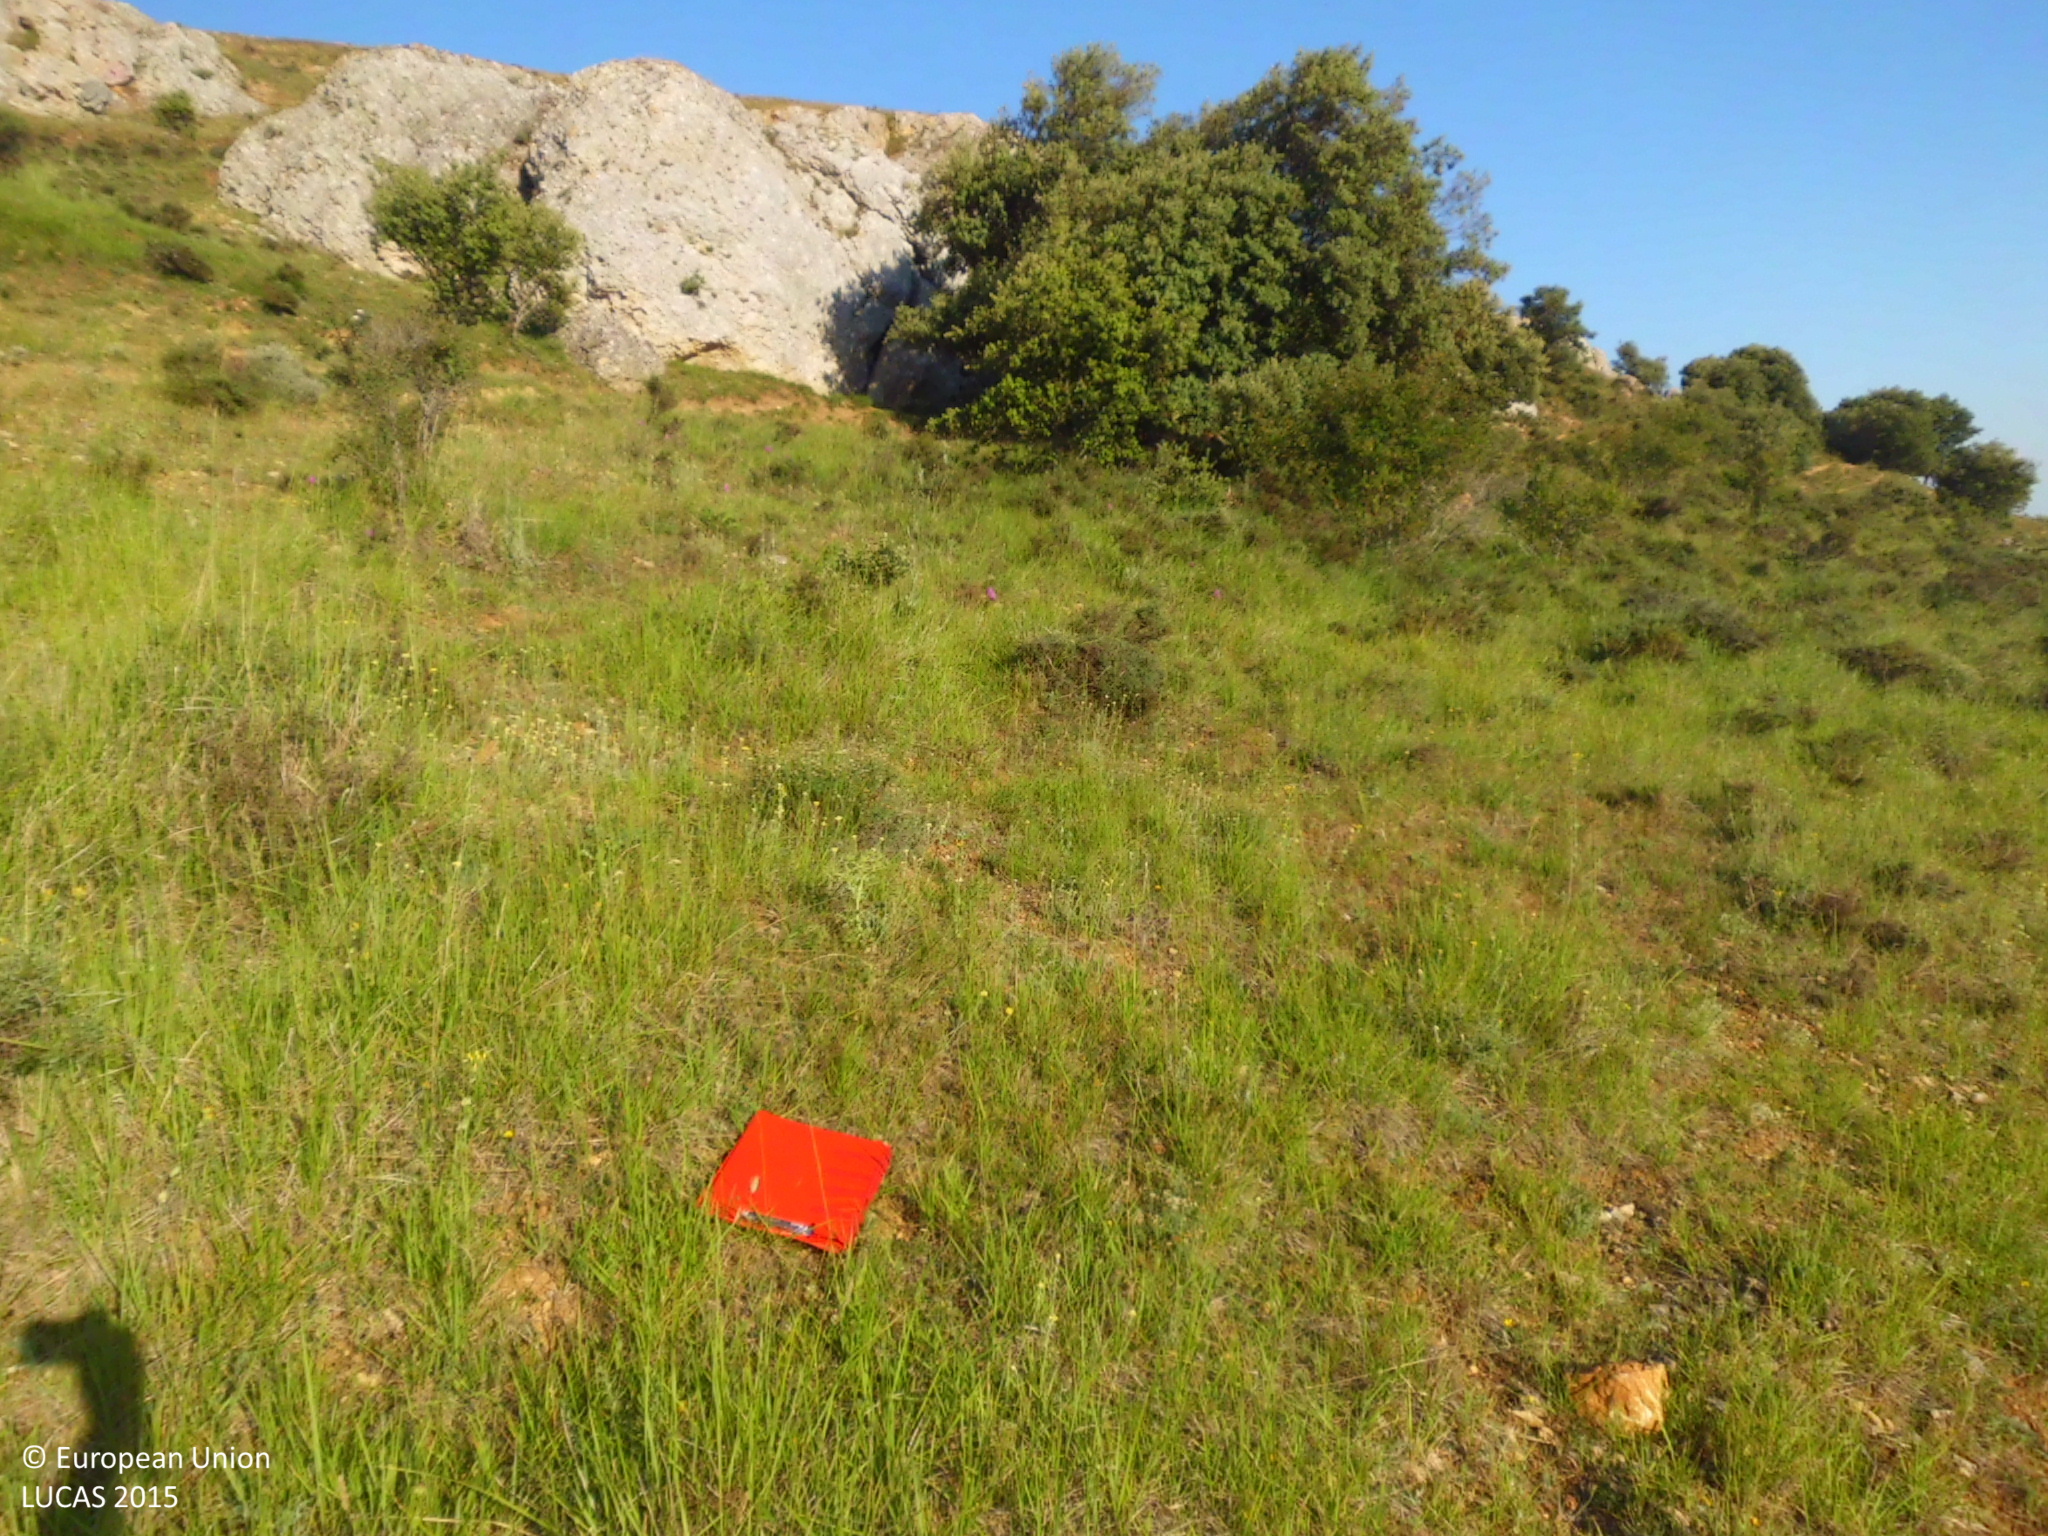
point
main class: Grassland
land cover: Grassland with sparse tree/shrub cover
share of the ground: > 75 %
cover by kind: herbaceous plants 90 %, broadleaved forest trees 5 %, shrubs 5 %
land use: Abandoned areas
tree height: < 5 m
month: June
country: ES
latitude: 42.5773
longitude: -3.9687
